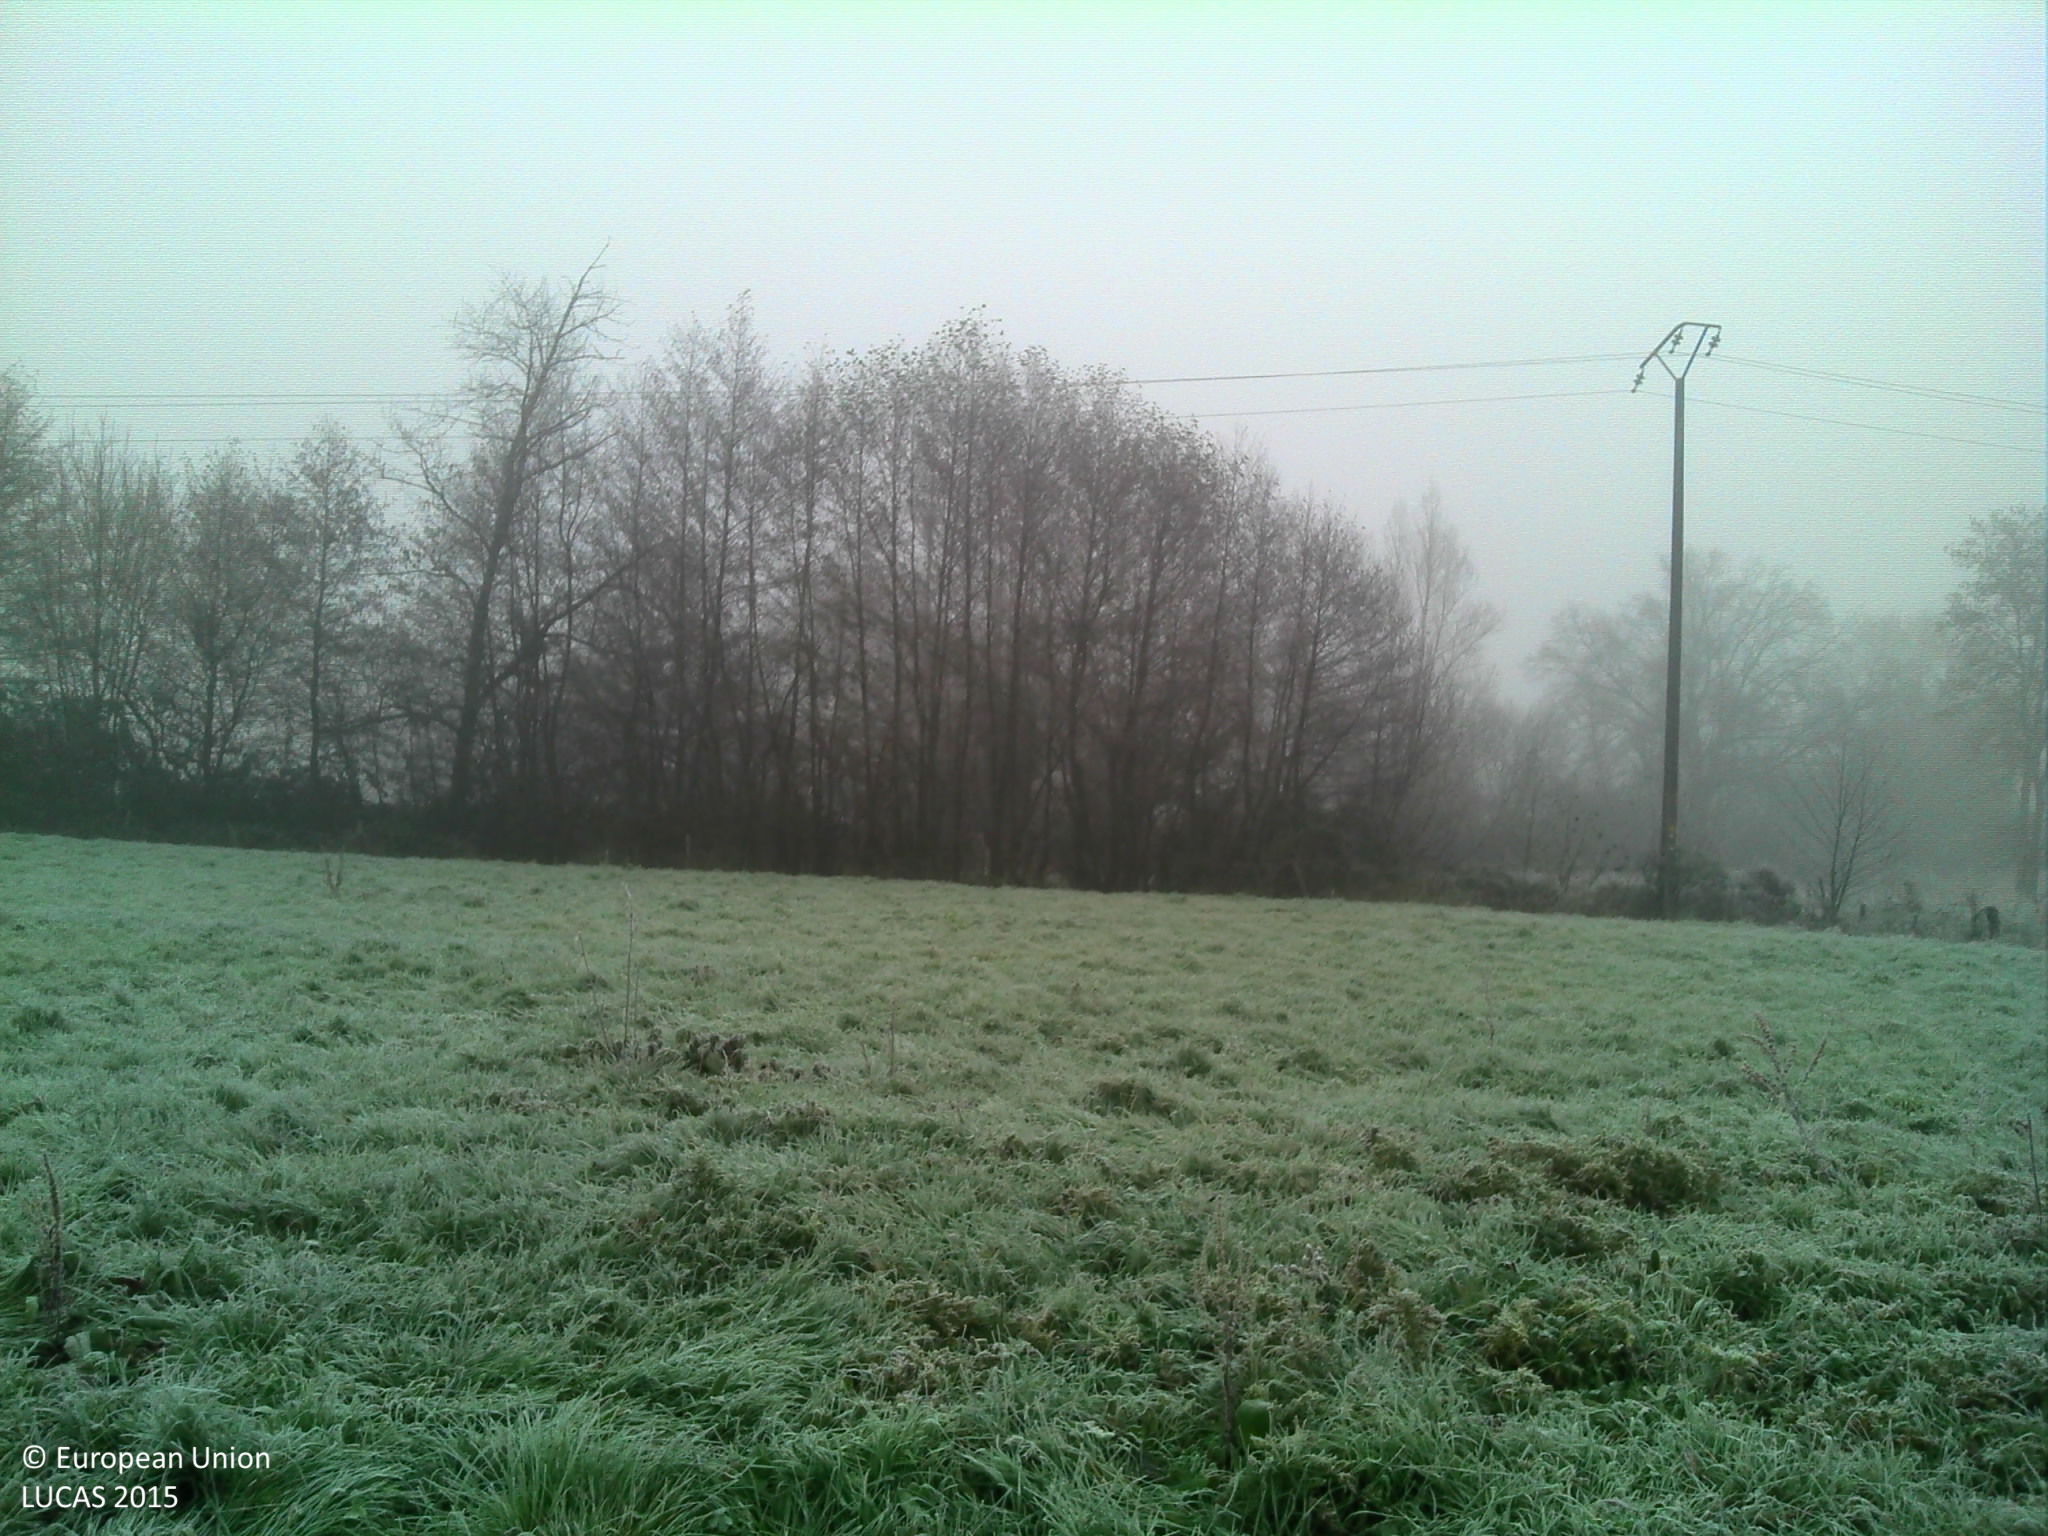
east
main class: Grassland
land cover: Grassland without tree/shrub cover
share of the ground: > 75 %
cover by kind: herbaceous plants 100 %
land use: Agriculture (excluding fallow land and kitchen gardens)
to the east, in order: Grassland without tree/shrub cover; Fences; Electric lines; Grass margins; Ditches and canals; Broadleaved woodland; Fences; Grassland without tree/shrub cover; Fences; Lines of trees; Grassland without tree/shrub cover; Fences; Abandoned hedges; Grassland without tree/shrub cover
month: November
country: FR
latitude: 46.5792
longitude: 3.6703
